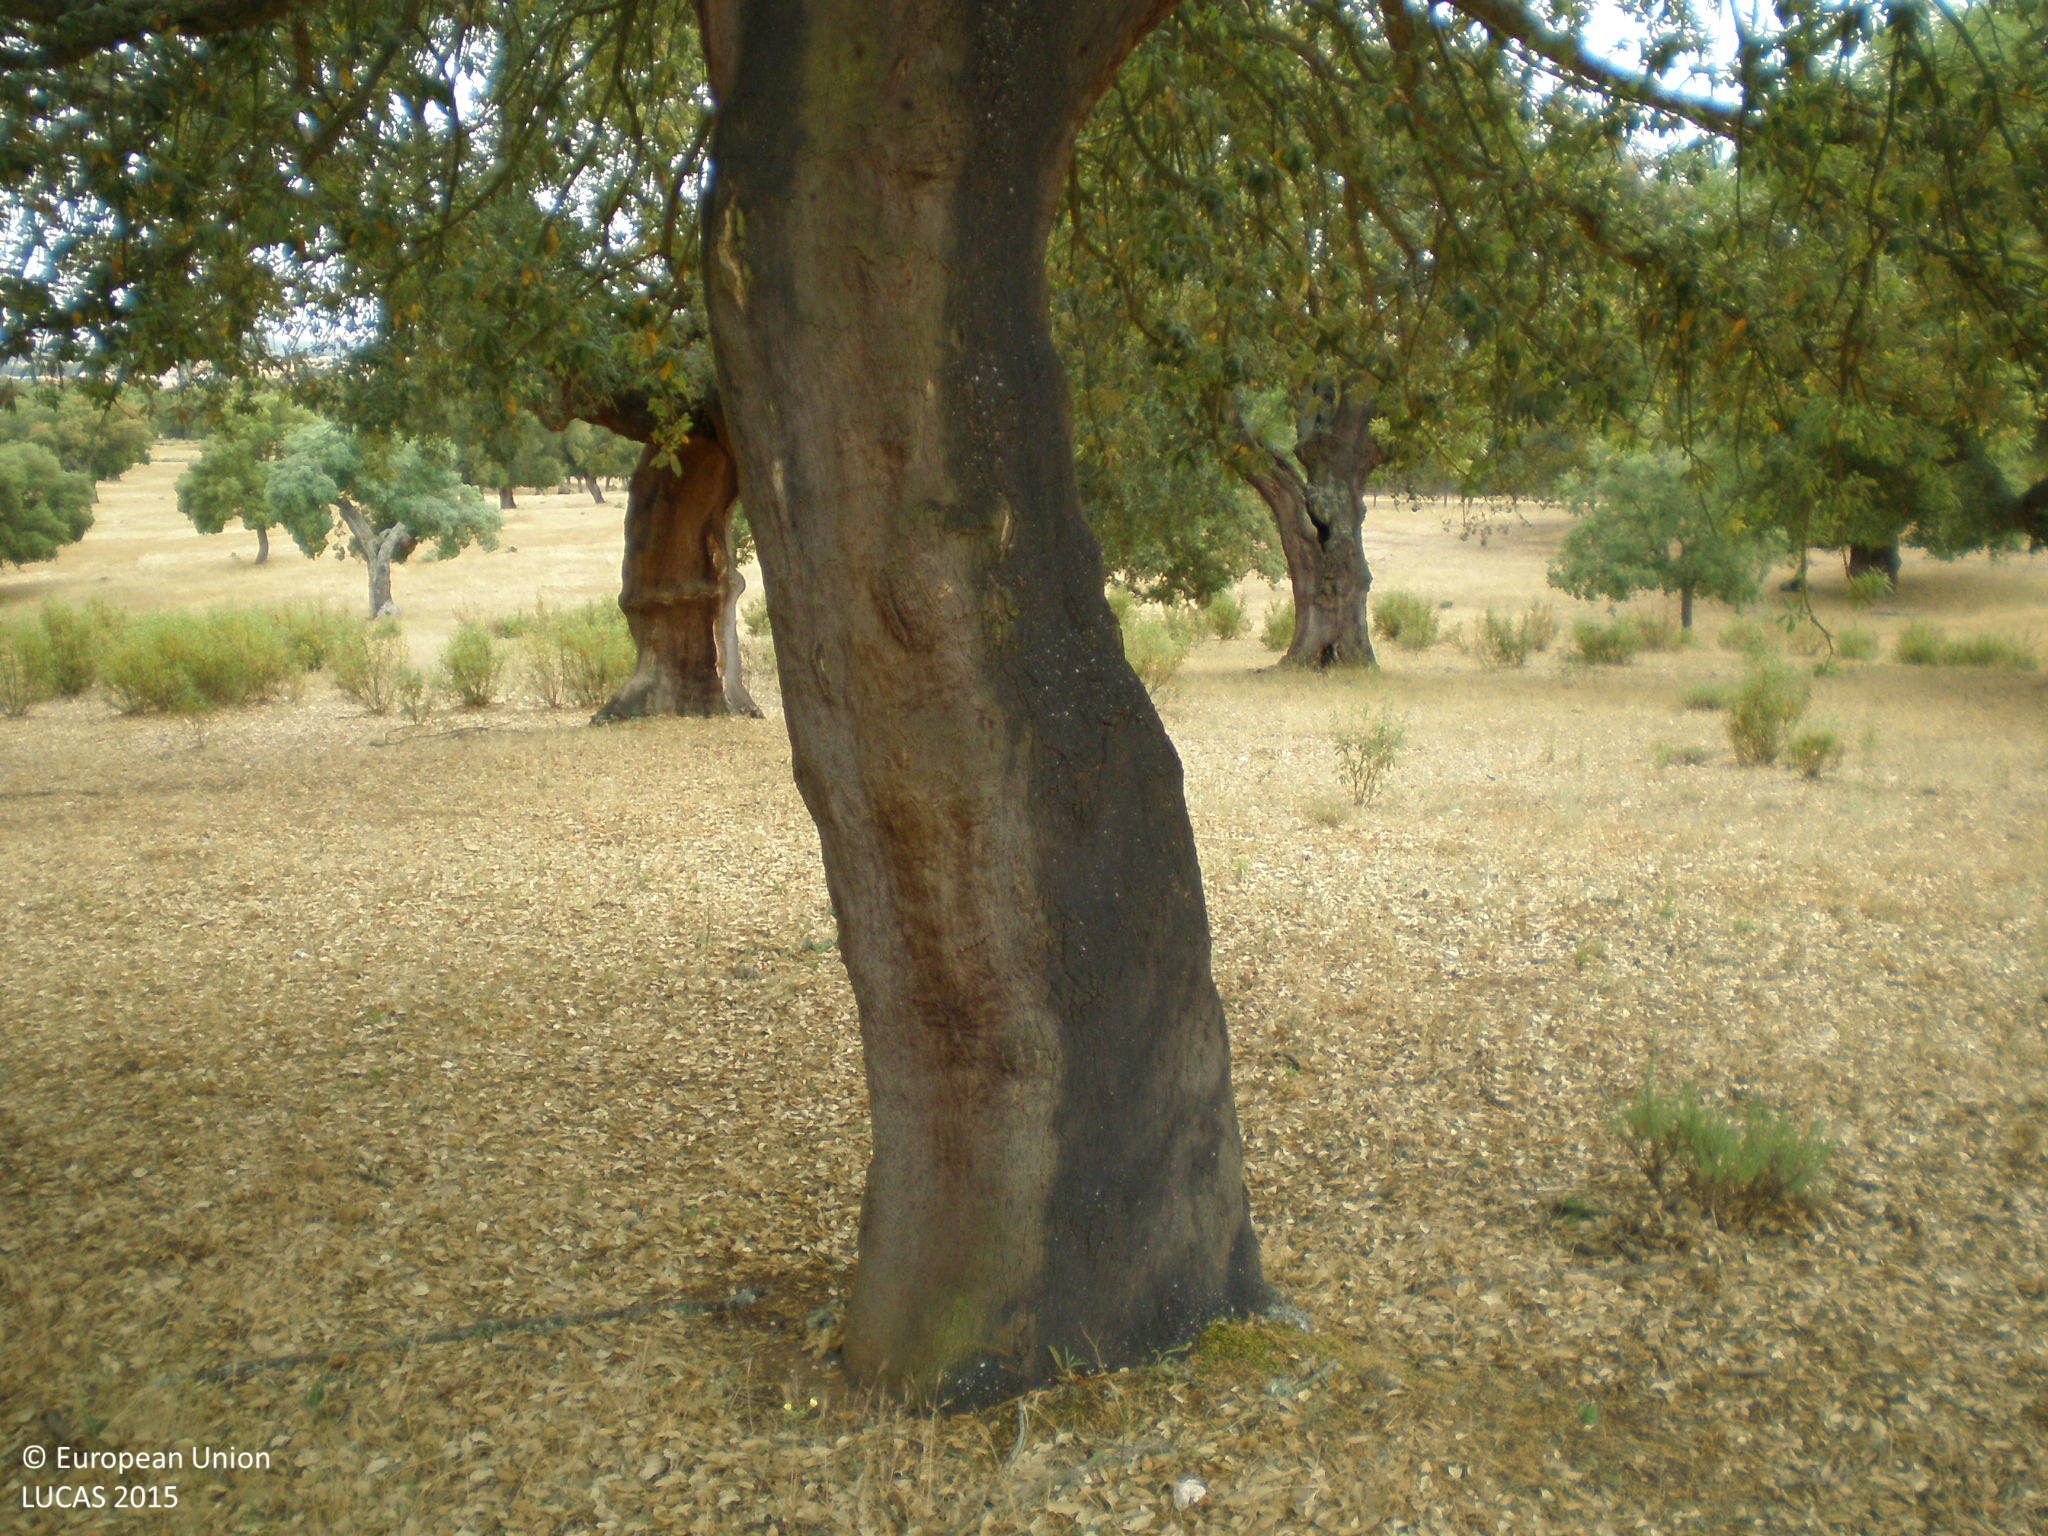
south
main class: Woodland
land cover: Broadleaved woodland
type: broadleaved evergreen forest
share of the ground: 25 - 50 %
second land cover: Grassland without tree/shrub cover
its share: 50 - 75 %
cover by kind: herbaceous plants 55 %, broadleaved forest trees 45 %
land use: Forestry
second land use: Agriculture (excluding fallow land and kitchen gardens)
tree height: > 5 m
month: June
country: ES
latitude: 41.1868
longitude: -5.7844
